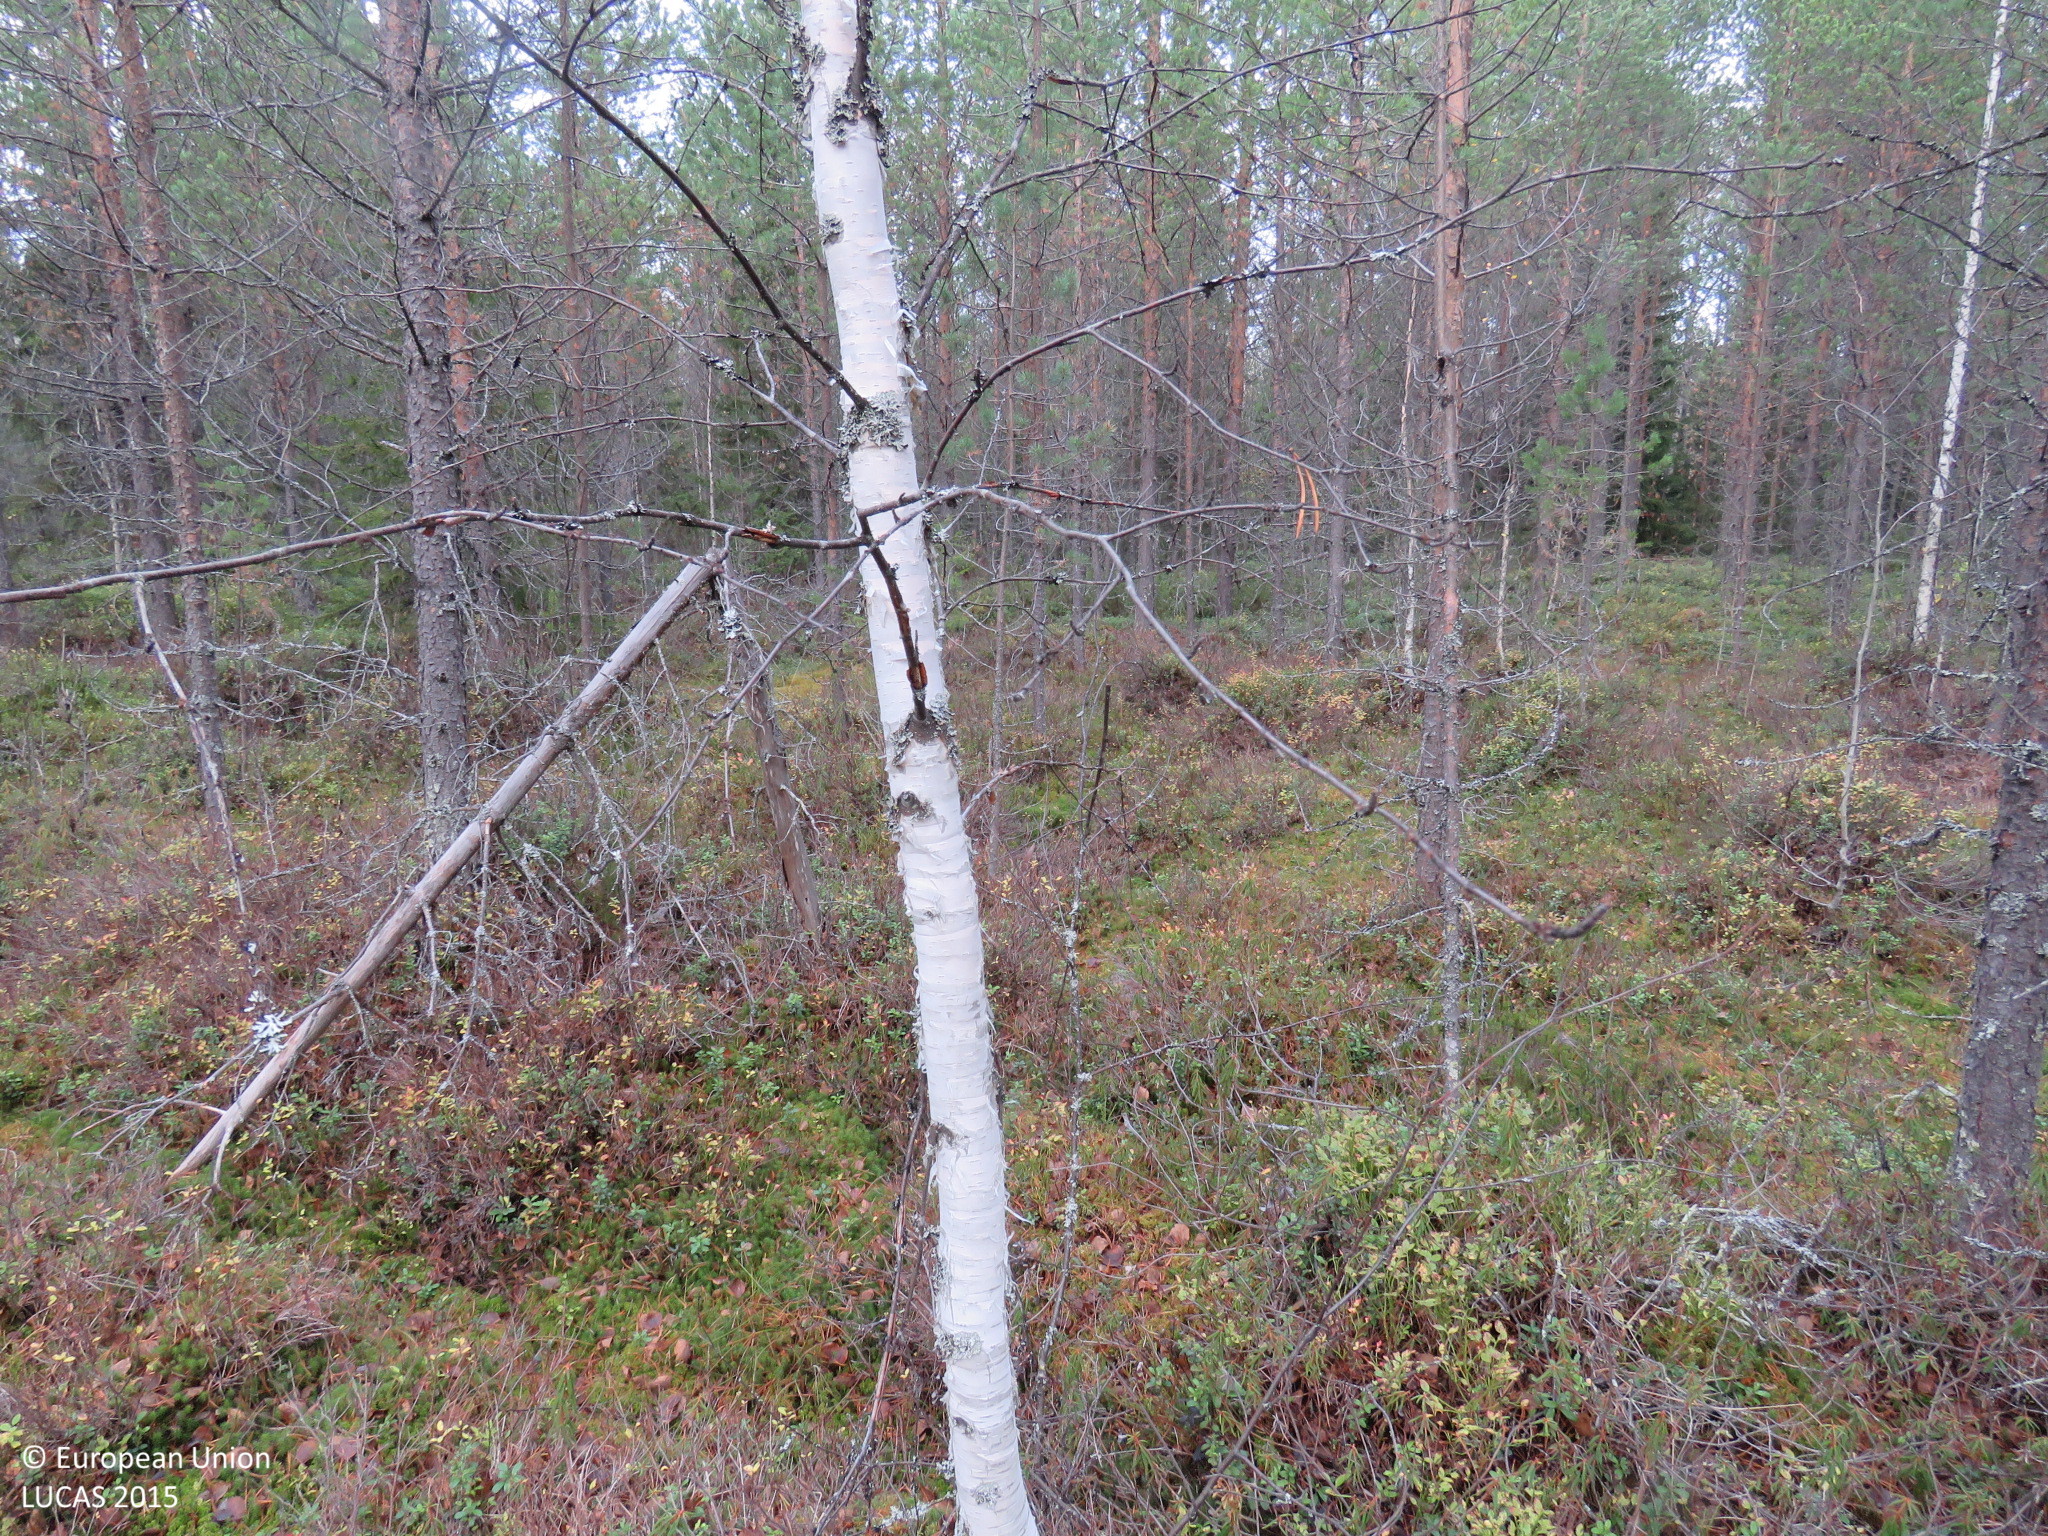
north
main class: Woodland
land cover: Pine dominated coniferous woodland
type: boreal forest
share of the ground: > 75 %
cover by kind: coniferous forest trees 60 %, shrubs 20 %, broadleaved forest trees 15 %, lichens and mosses 5 %
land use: Forestry
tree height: > 5 m
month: October
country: FI
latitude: 64.5652
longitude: 27.0101
